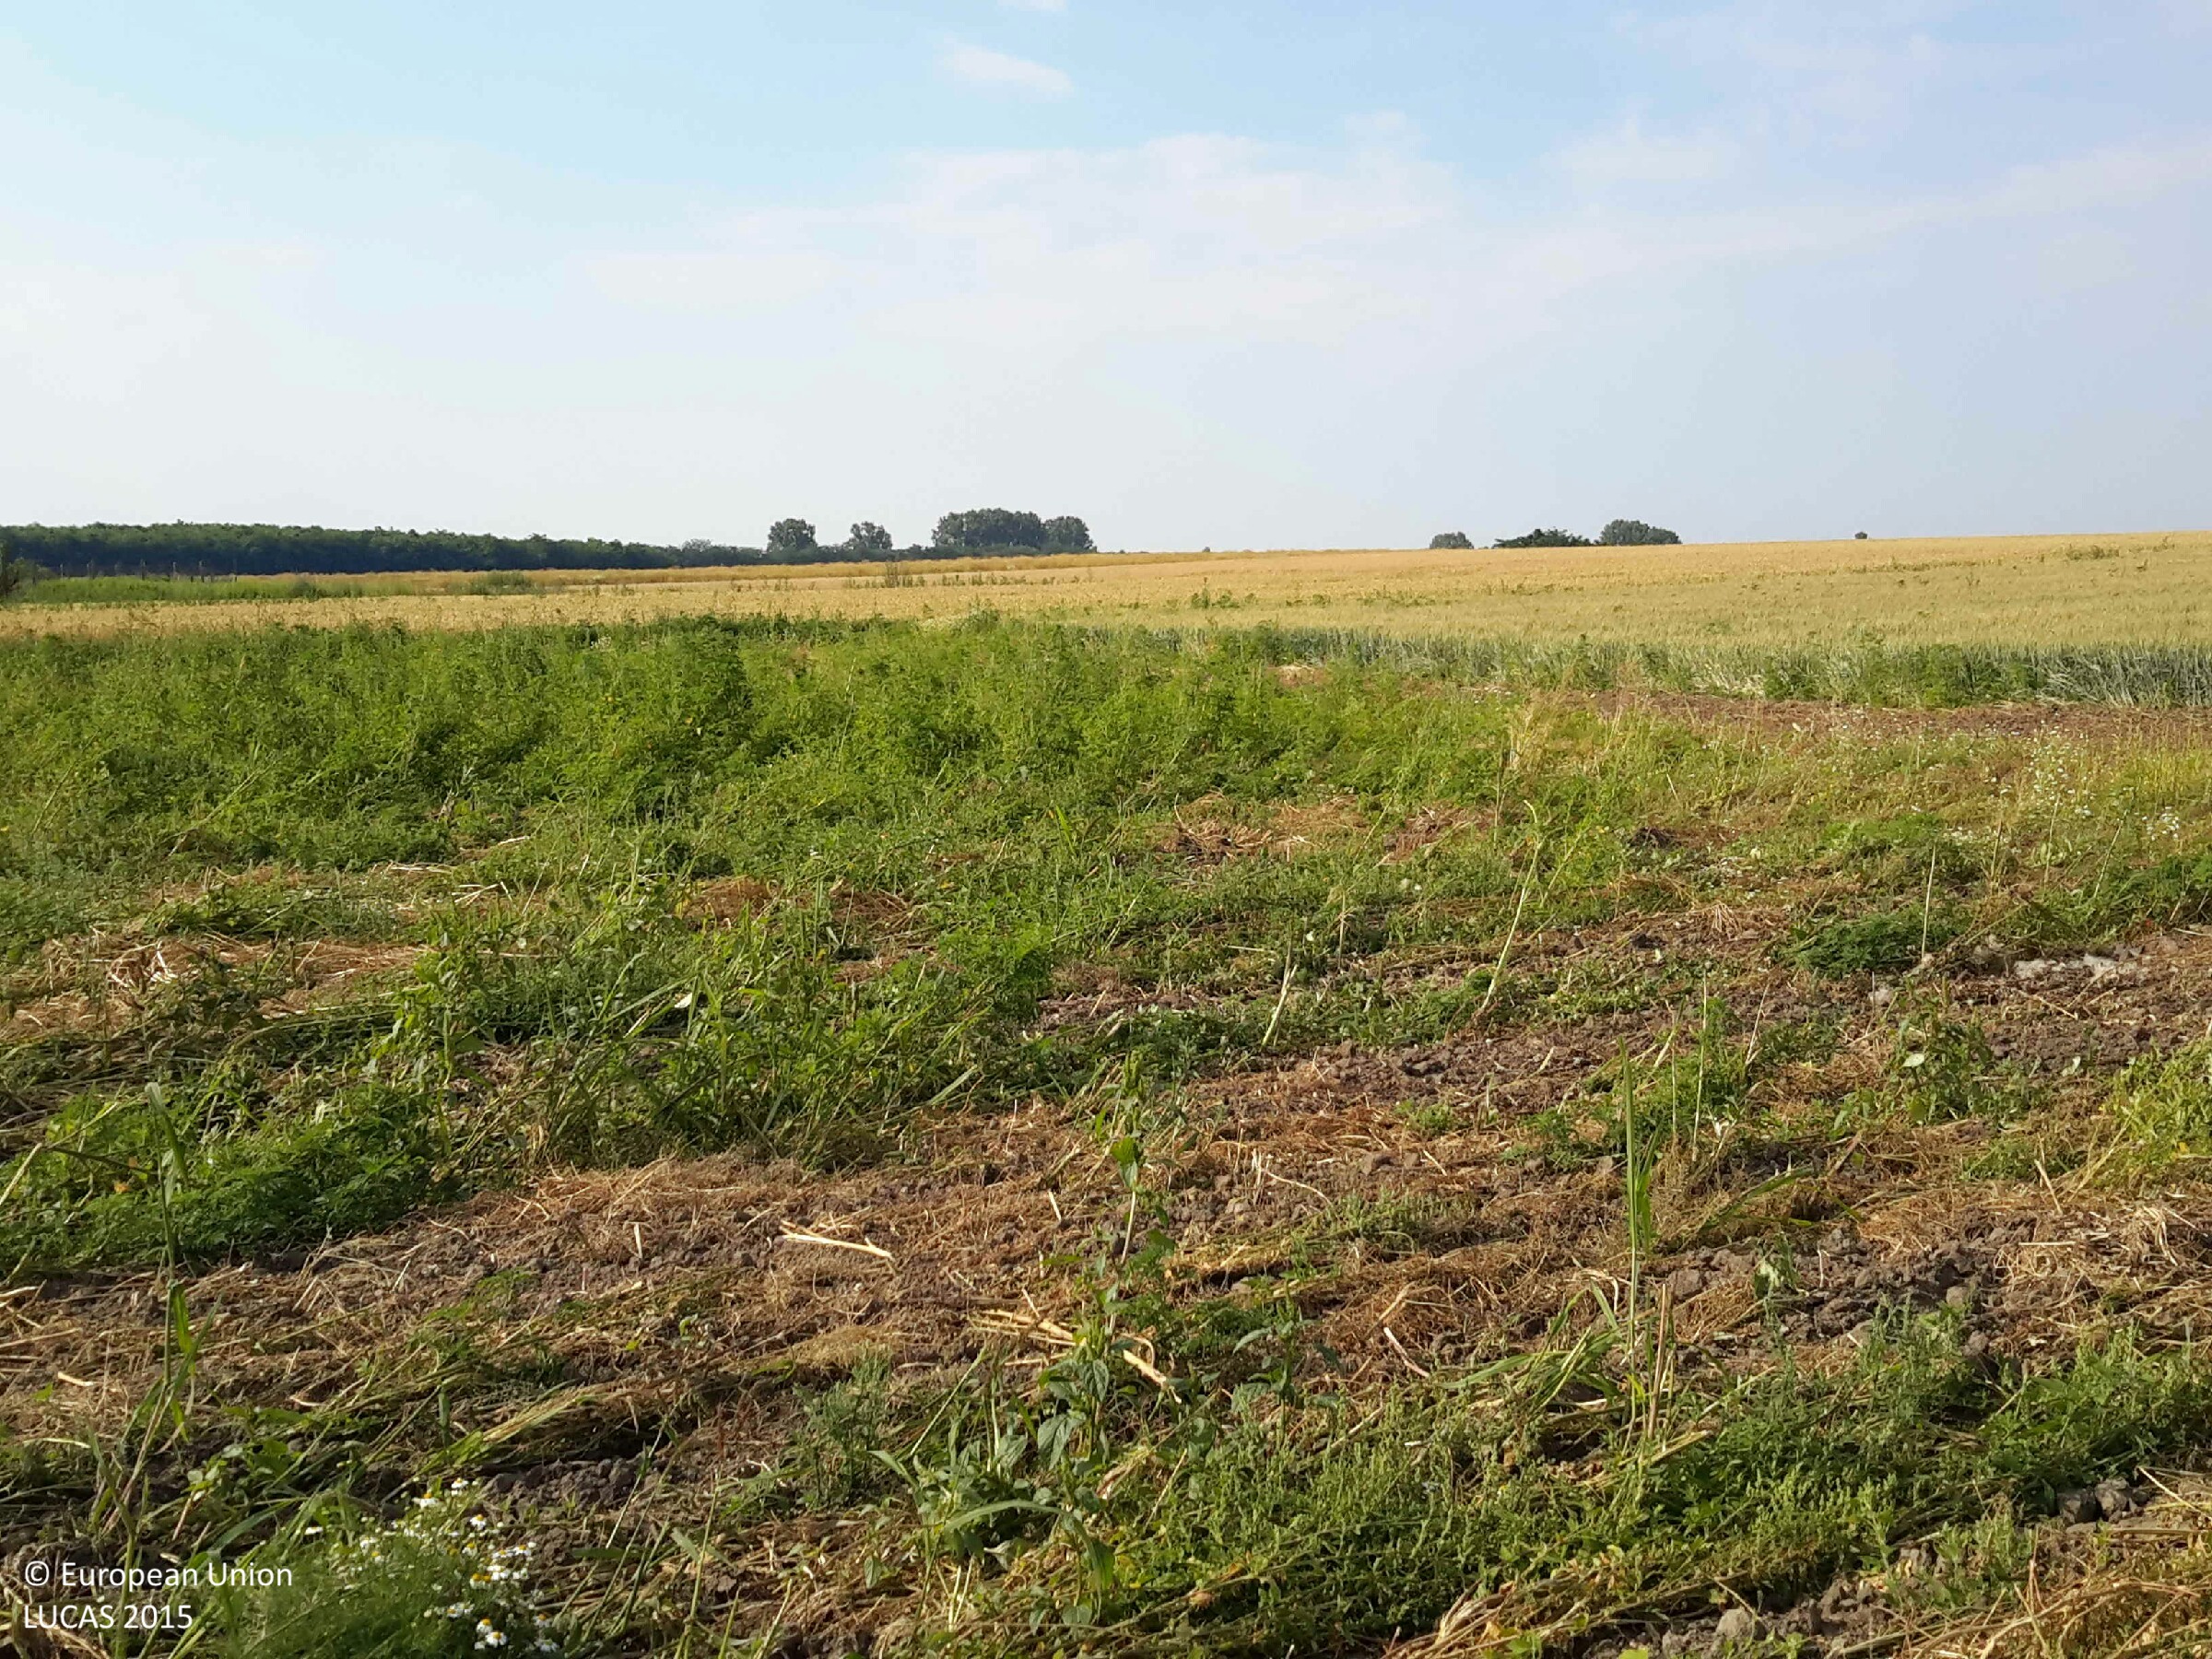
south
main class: Grassland
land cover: Spontaneously vegetated surfaces
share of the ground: 50 - 75 %
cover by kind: herbaceous plants 60 %, unconsolidated bare surface 40 %
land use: Fallow land
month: July
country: HU
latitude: 47.3918
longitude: 17.4662
